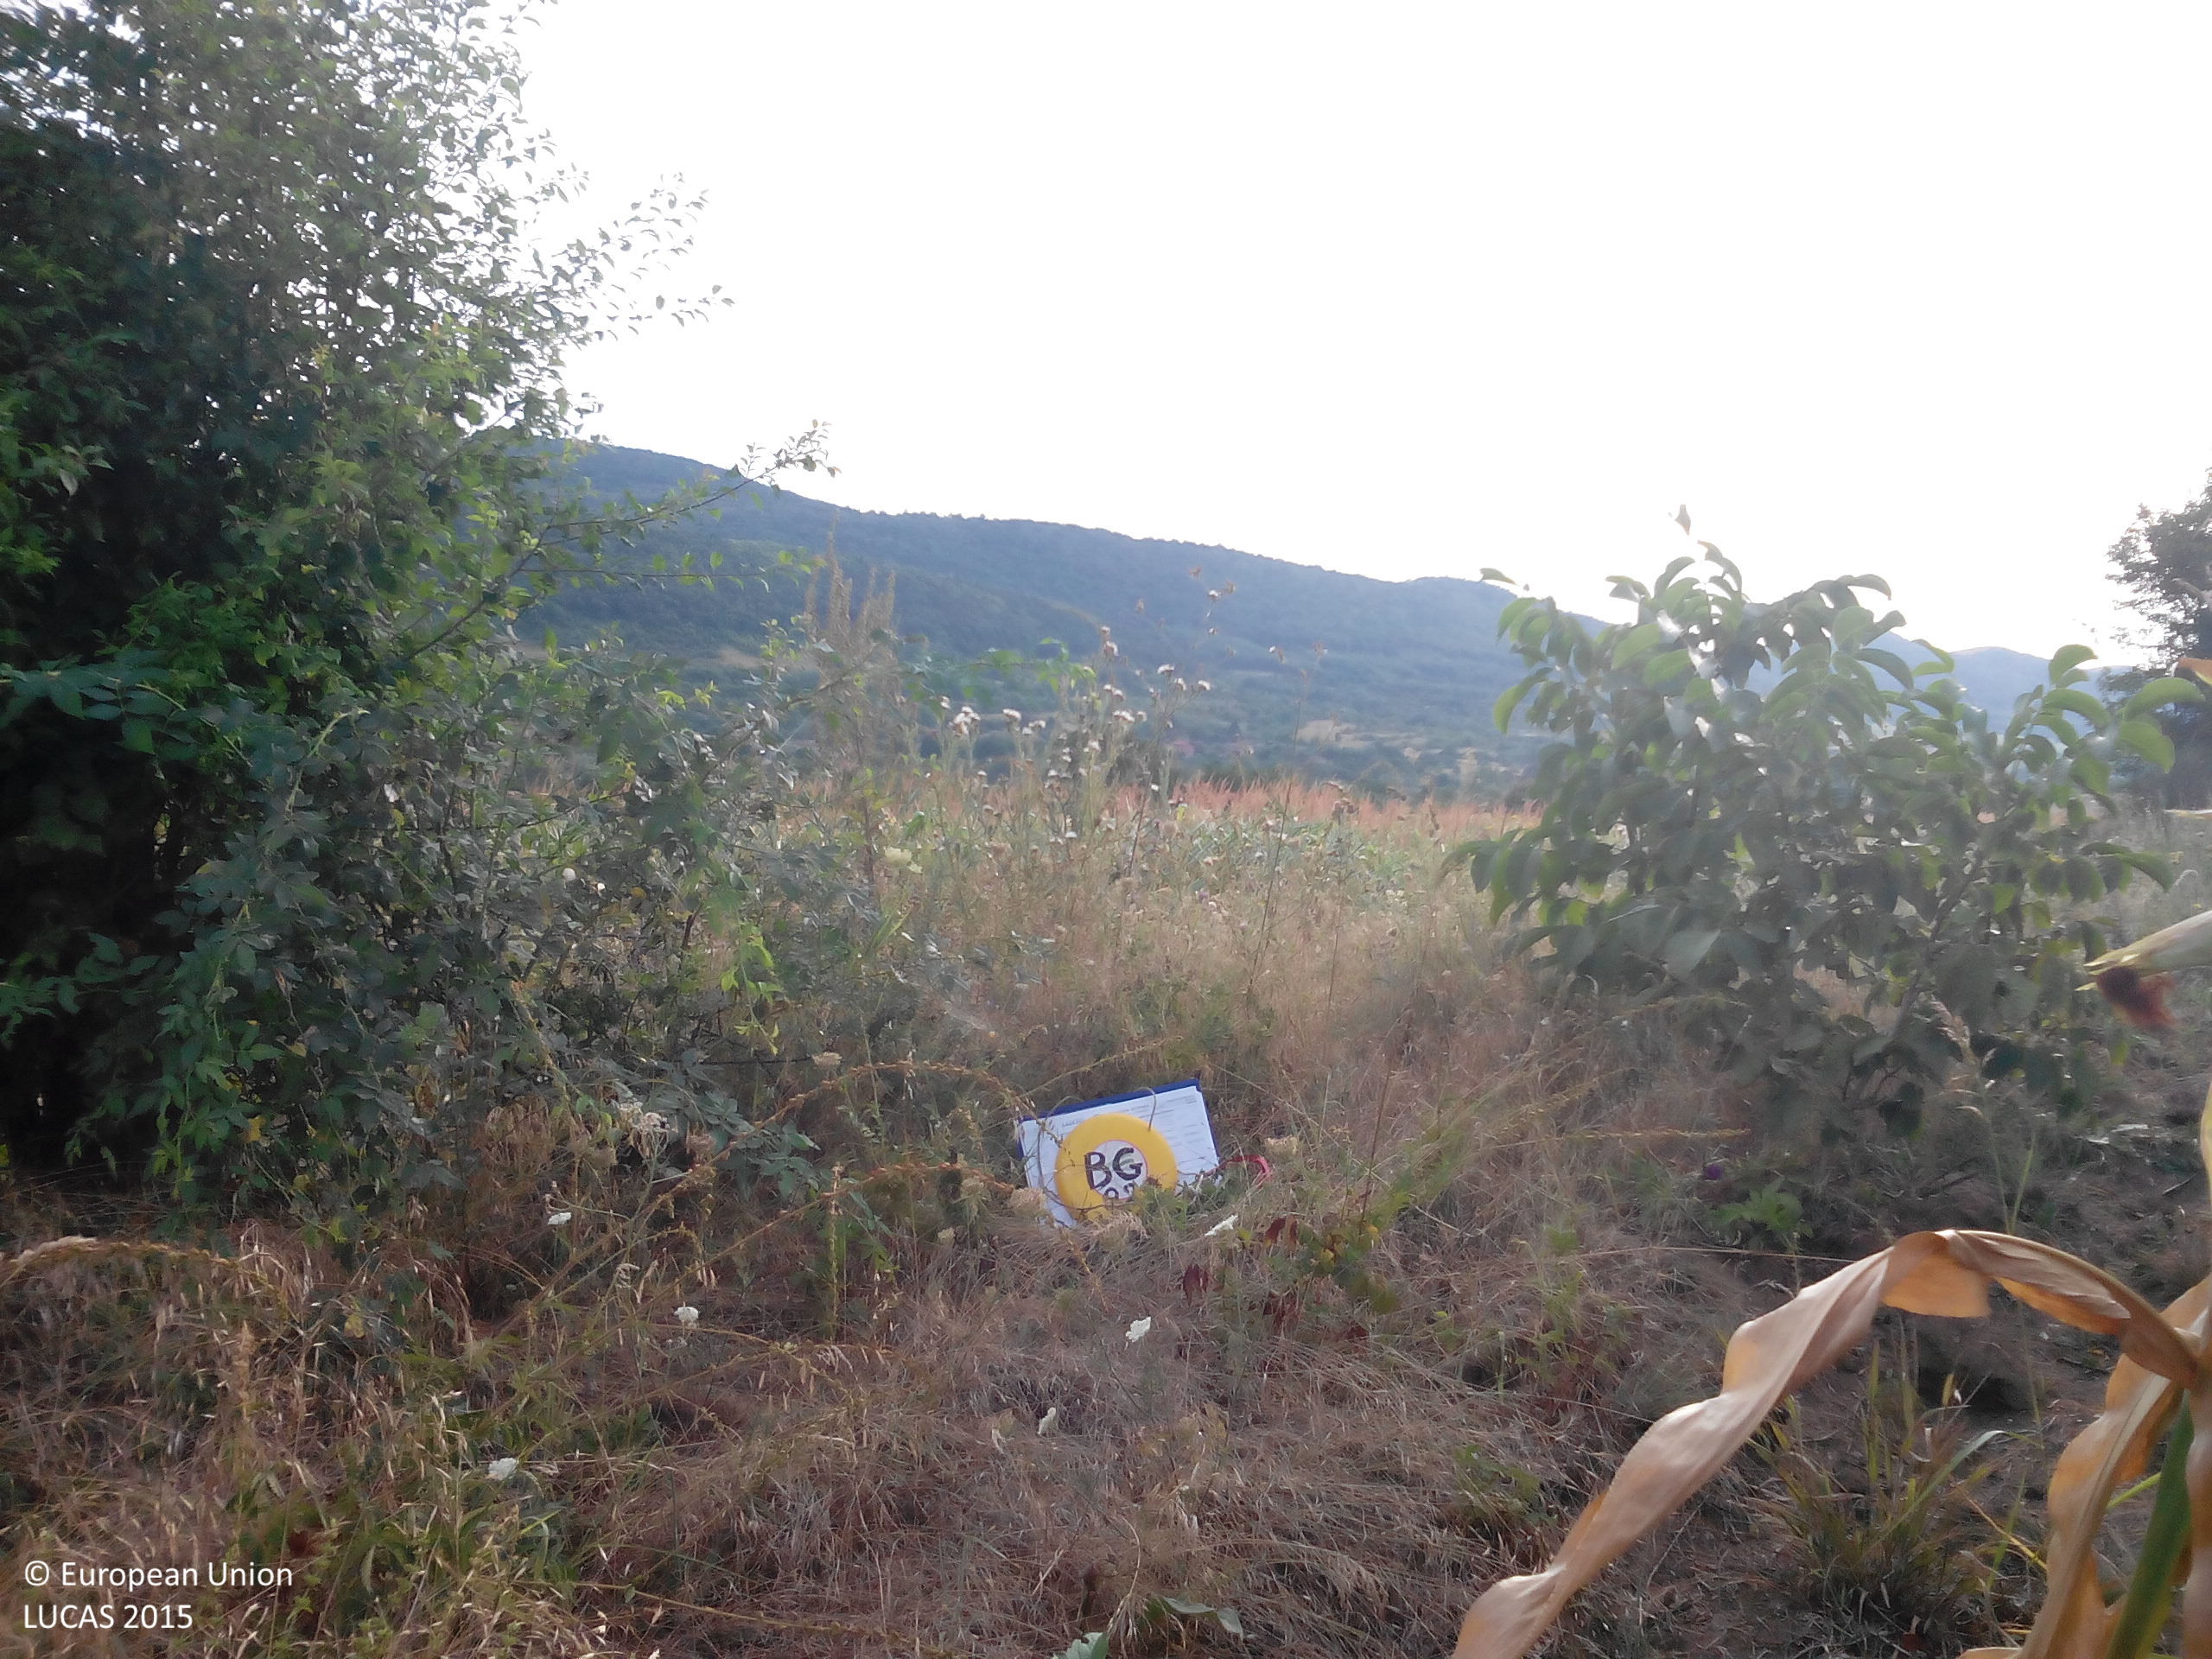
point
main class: Shrubland
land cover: Shrubland with sparse tree cover
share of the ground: 25 - 50 %
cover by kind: herbaceous plants 65 %, shrubs 30 %, broadleaved forest trees 5 %
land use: Semi-natural and natural areas not in use
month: August
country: BG
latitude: 43.1916
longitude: 23.8911
